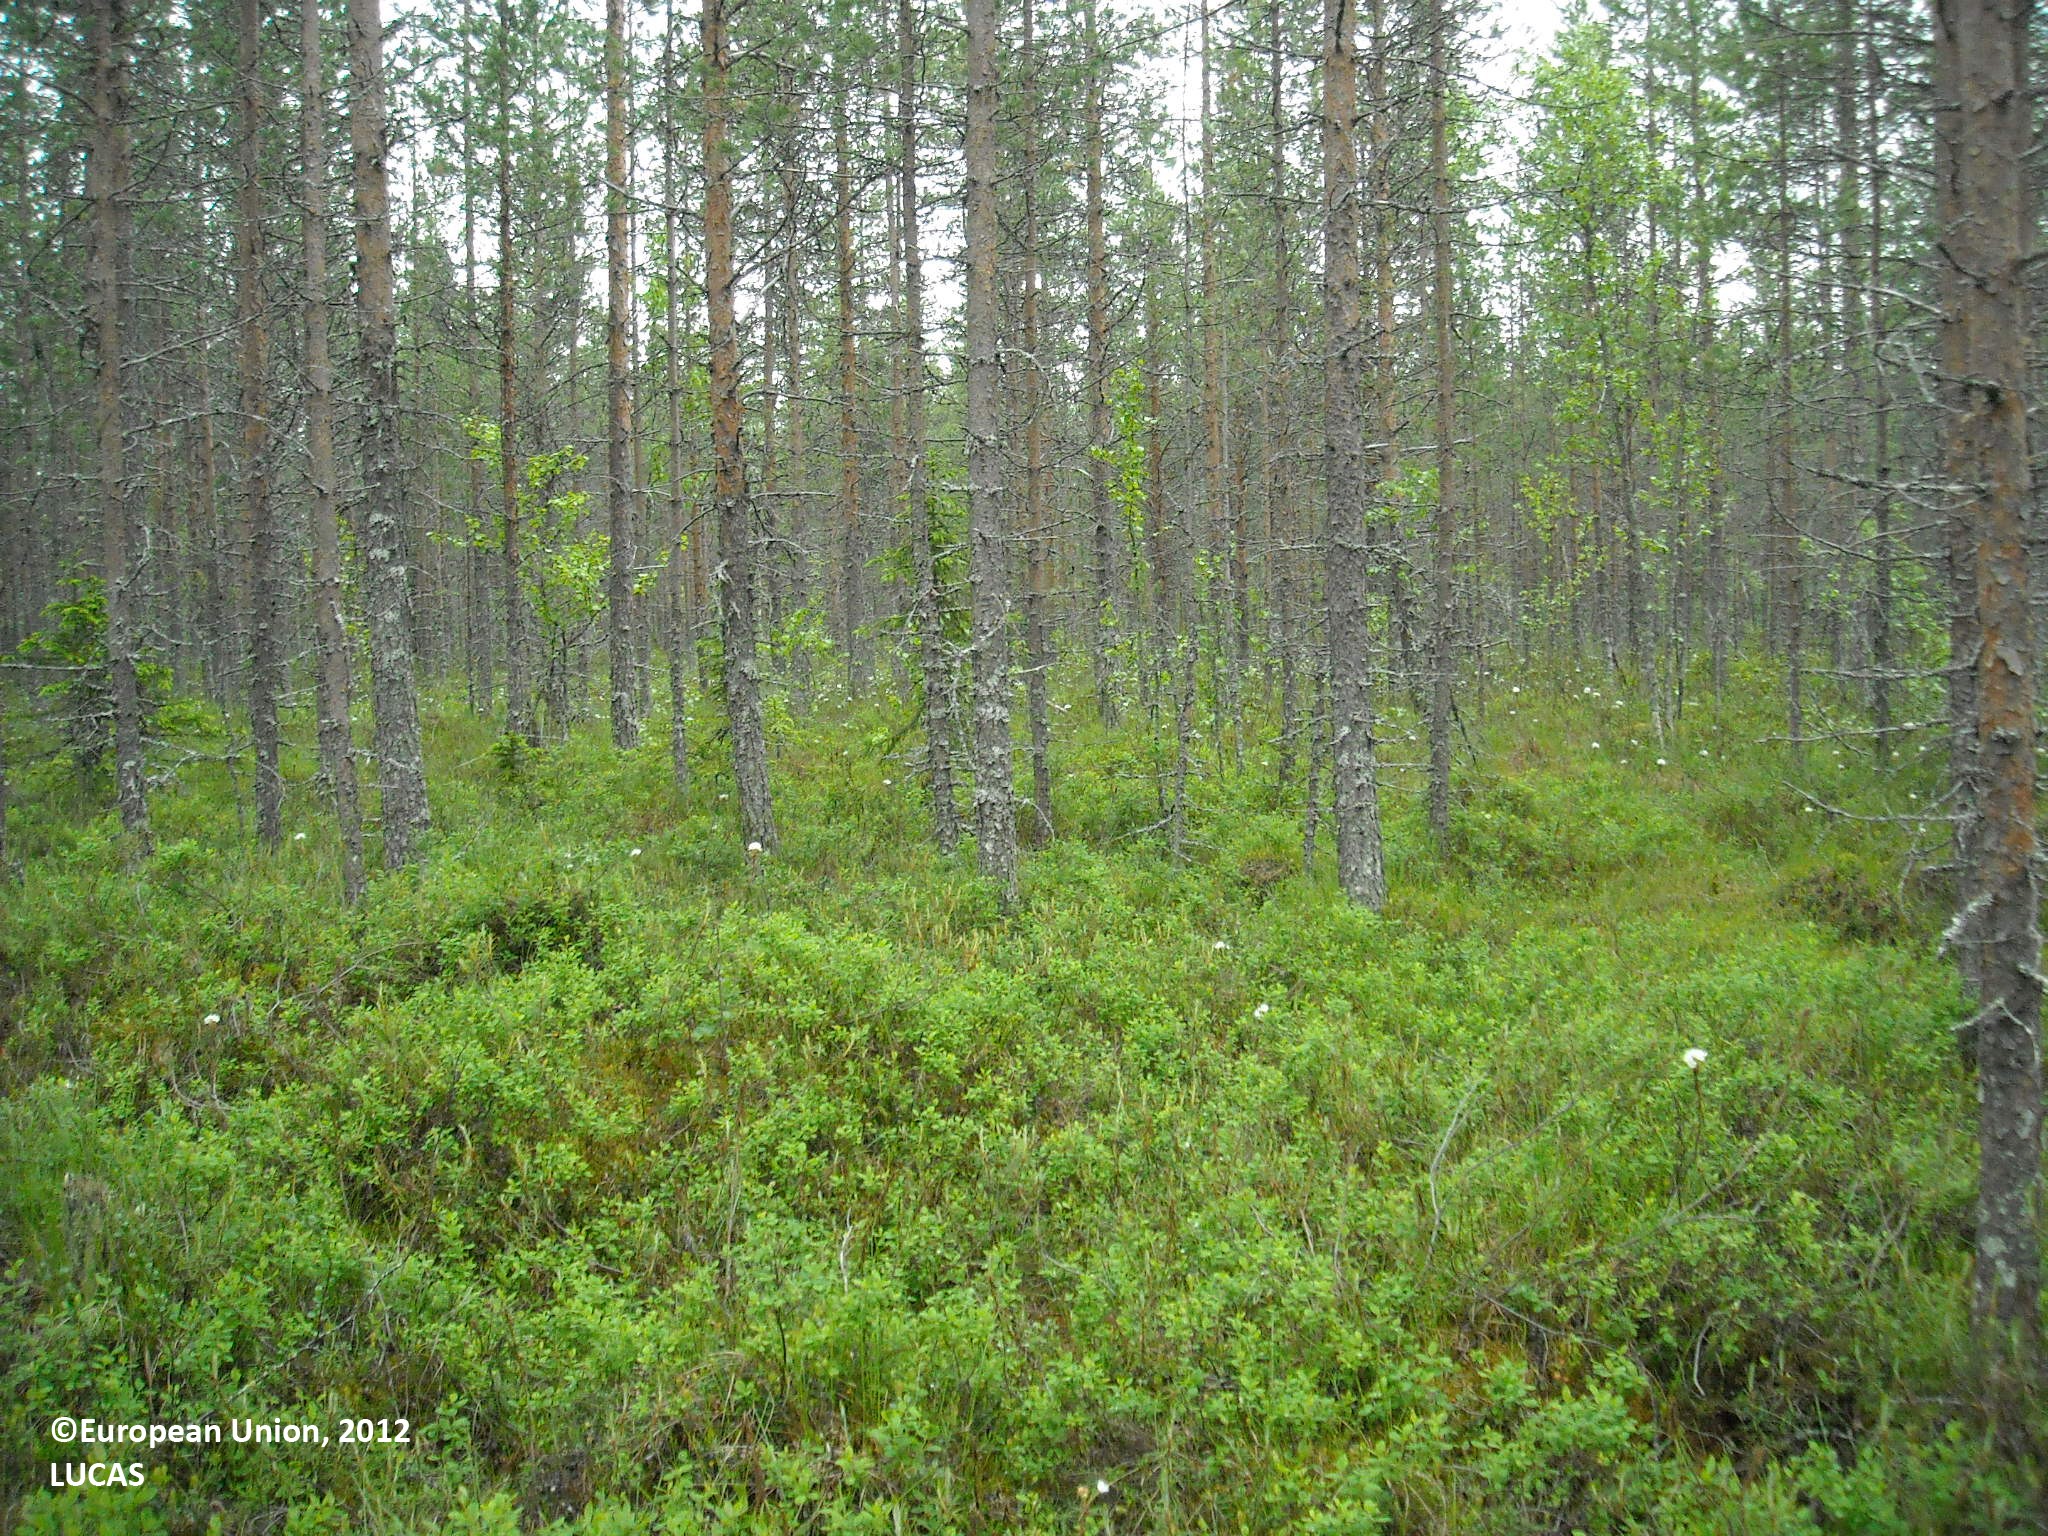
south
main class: Woodland
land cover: Pine dominated coniferous woodland
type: mire and swamp forests
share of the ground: 50 - 75 %
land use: Forestry
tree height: > 5 m
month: June
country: FI
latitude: 64.8474
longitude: 27.4925
